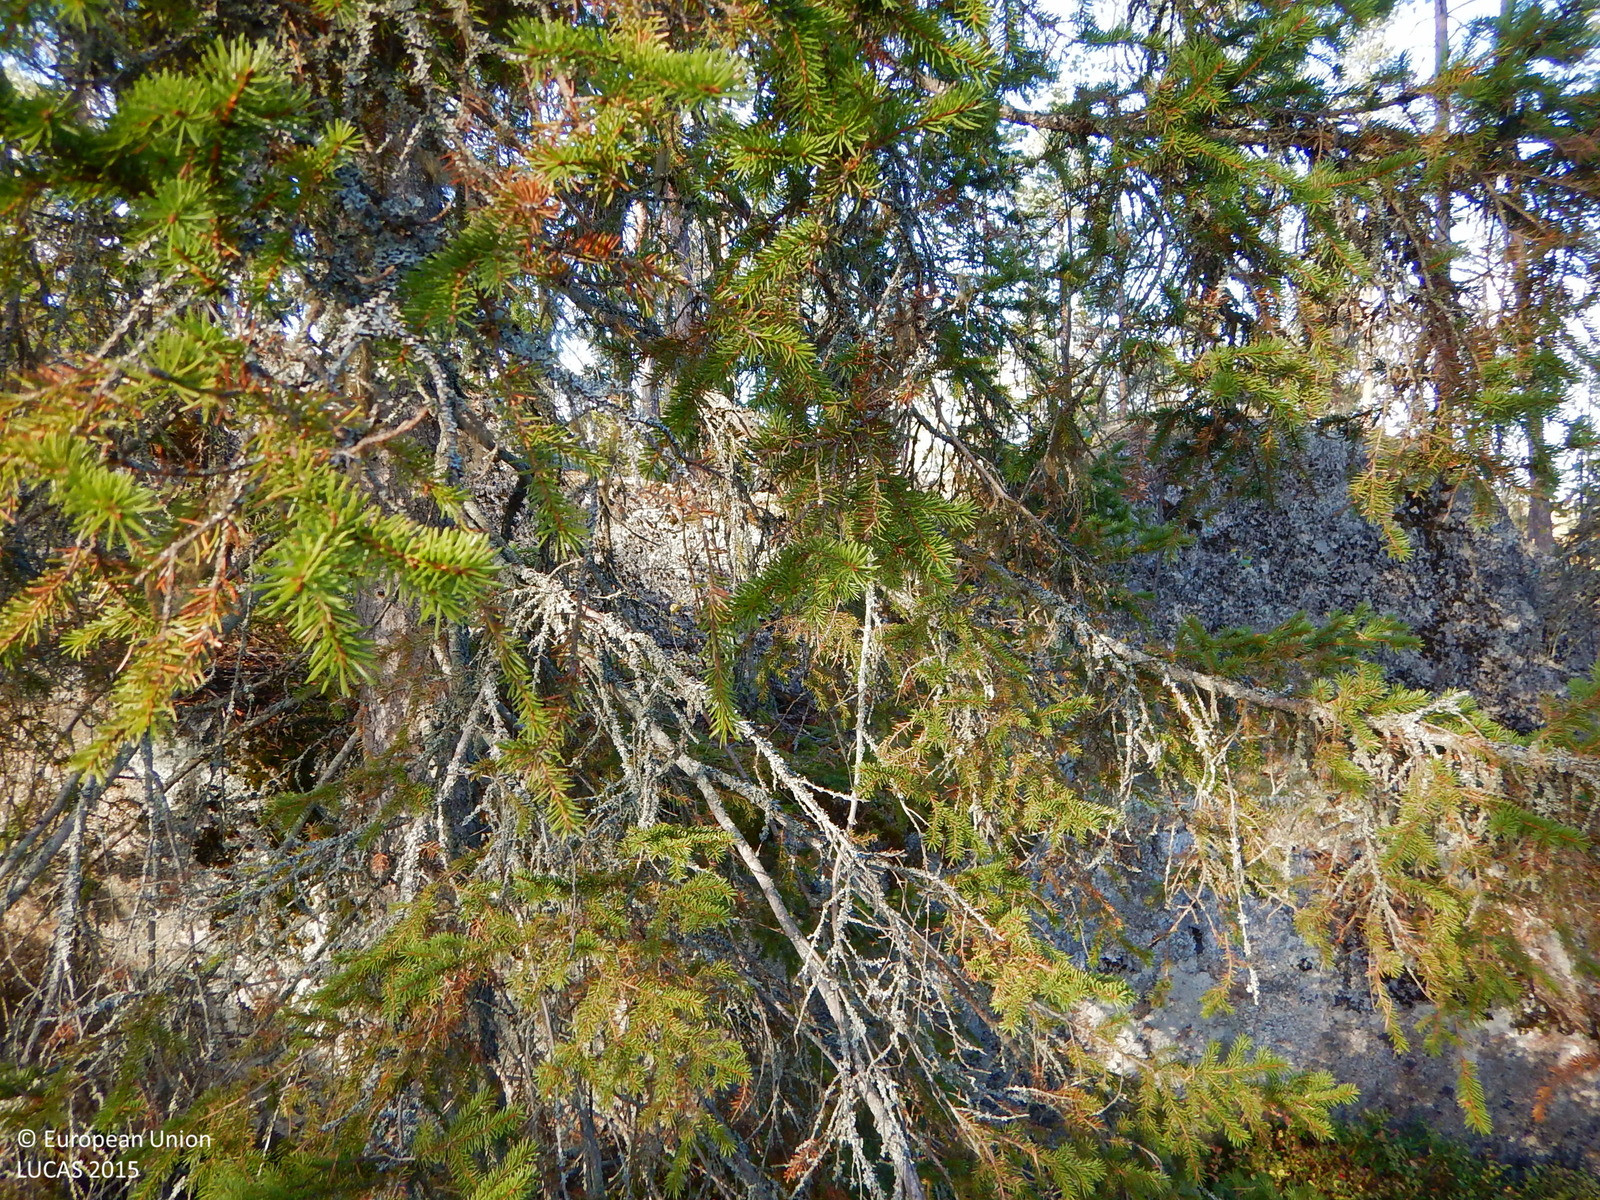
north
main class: Woodland
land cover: Other coniferous woodland
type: boreal forest
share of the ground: 50 - 75 %
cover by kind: coniferous forest trees 50 %, shrubs 20 %, lichens and mosses 20 %, herbaceous plants 5 %, consolidated bare surface 5 %
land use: Forestry
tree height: > 5 m
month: October
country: SE
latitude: 64.9167
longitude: 20.9057
